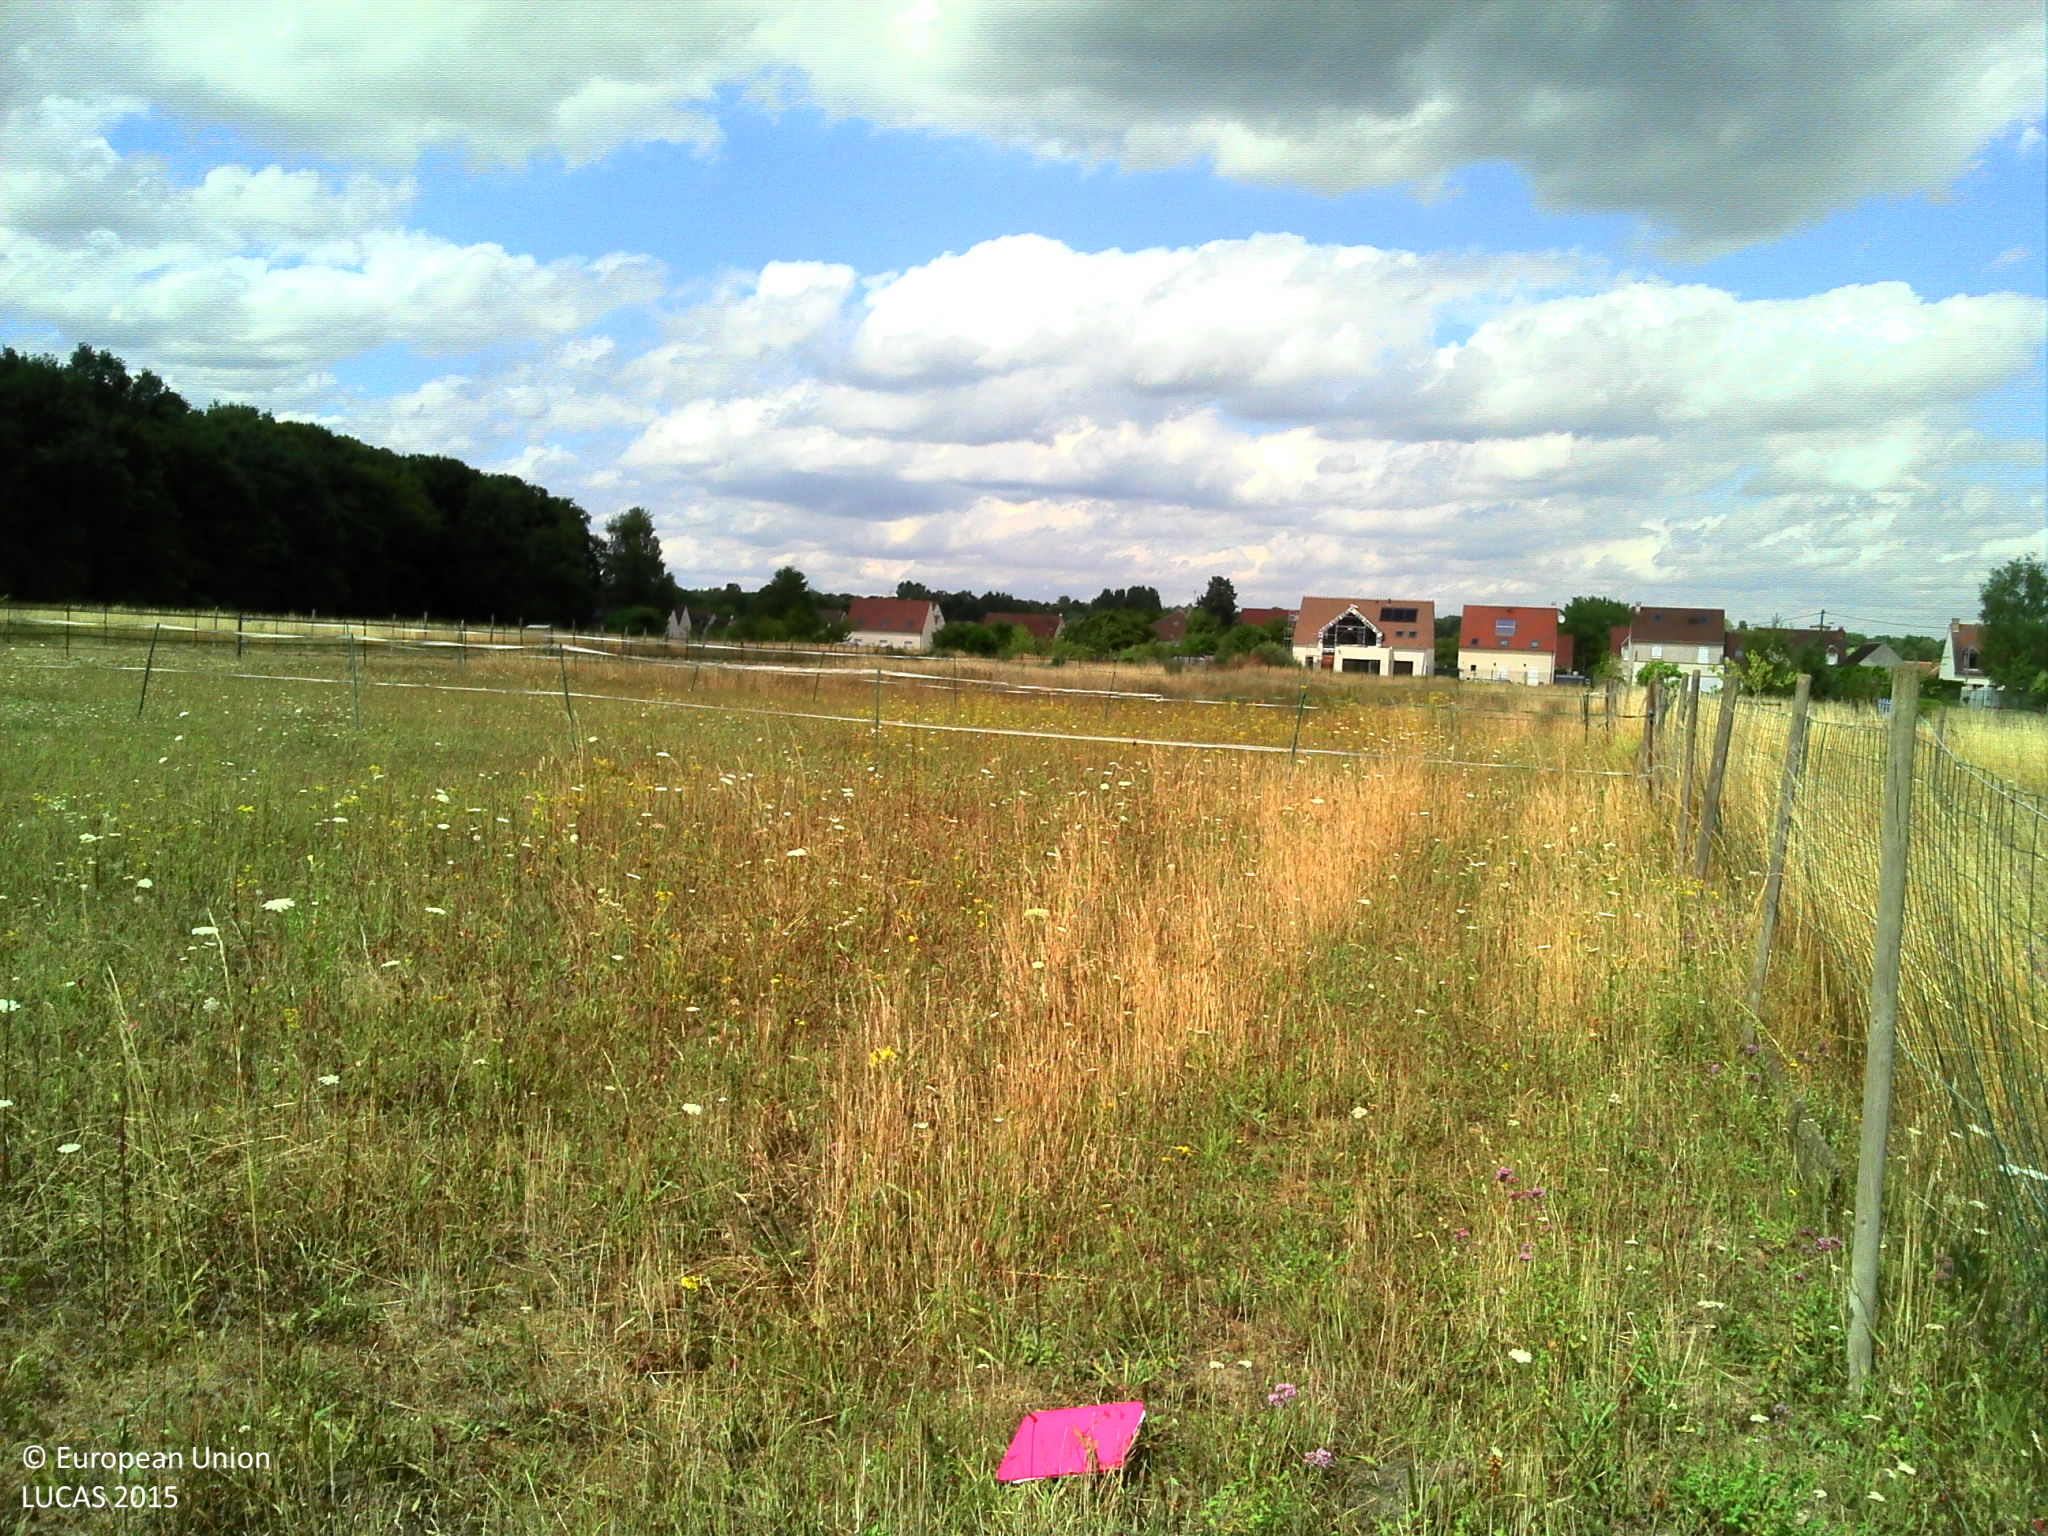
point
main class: Grassland
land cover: Grassland without tree/shrub cover
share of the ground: > 75 %
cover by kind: herbaceous plants 100 %
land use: Agriculture (excluding fallow land and kitchen gardens)
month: July
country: FR
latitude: 49.1471
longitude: 2.5720
